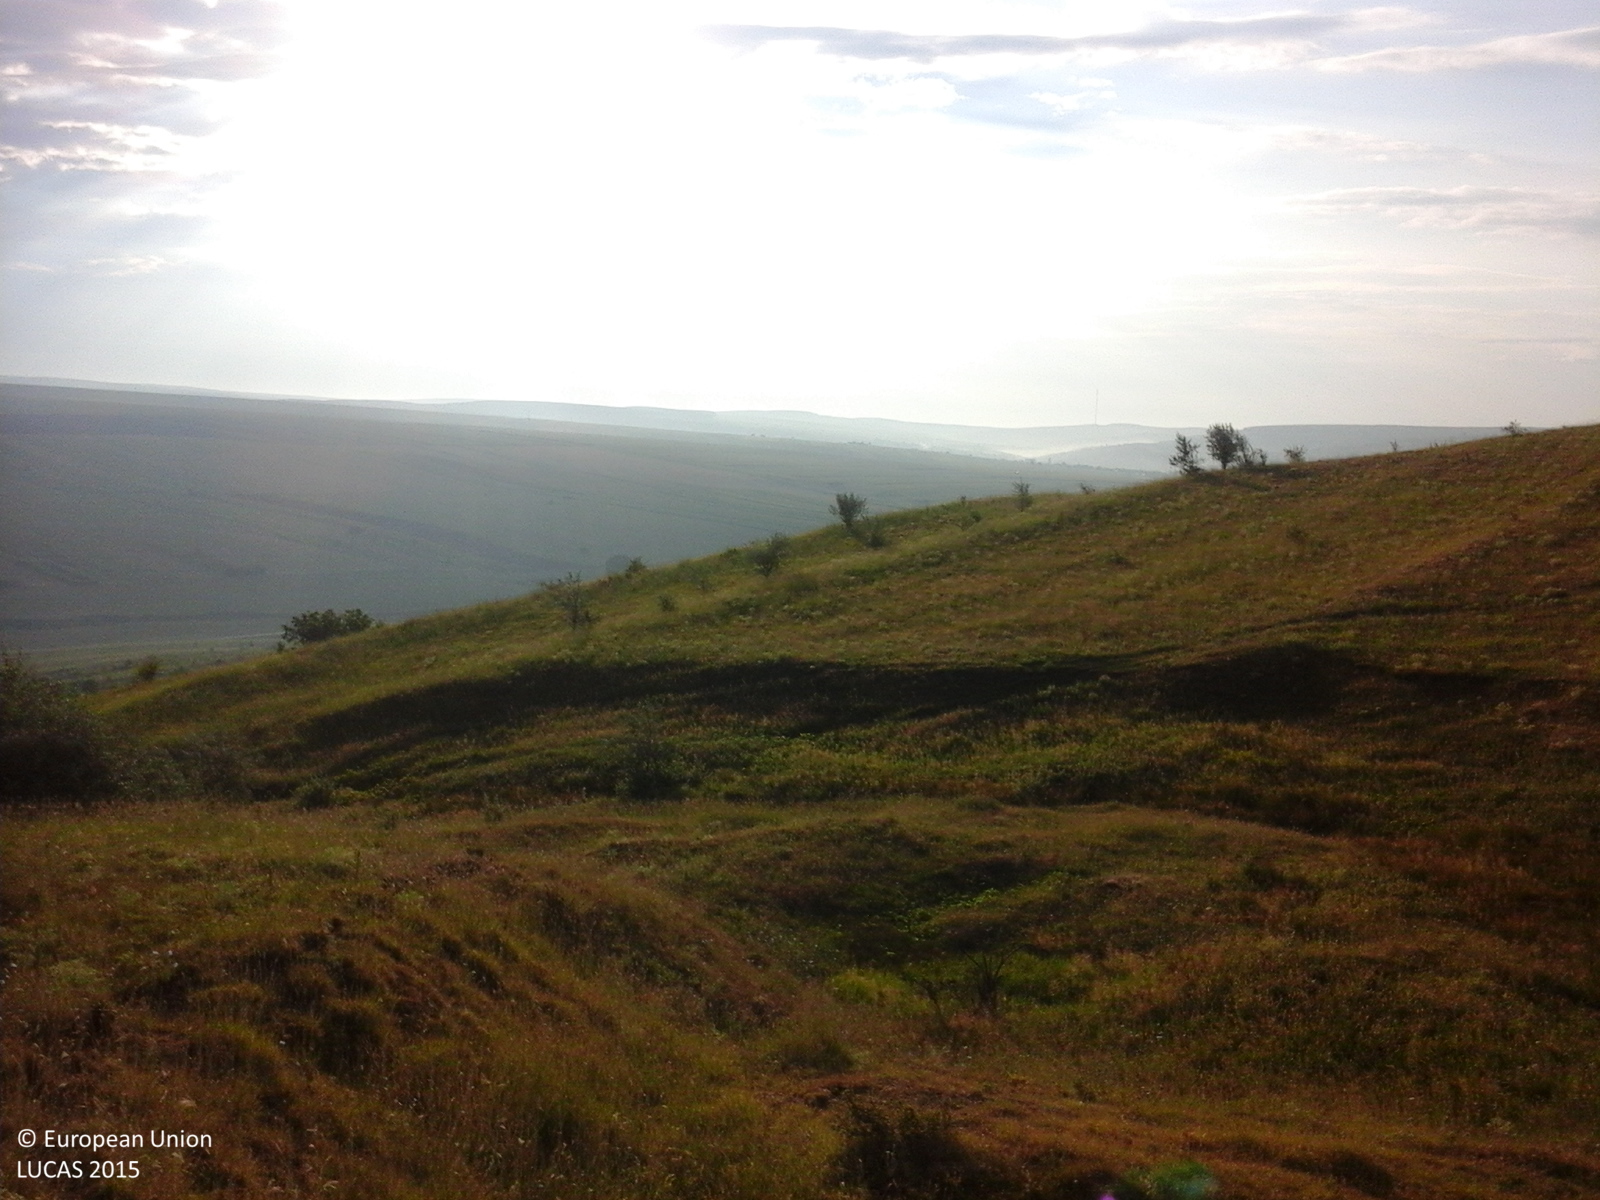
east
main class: Grassland
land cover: Grassland without tree/shrub cover
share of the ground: > 75 %
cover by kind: herbaceous plants 100 %
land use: Agriculture (excluding fallow land and kitchen gardens)
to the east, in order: Grassland without tree/shrub cover; Grassland with sparse tree/shrub cover; Grassland without tree/shrub cover; Grassland with sparse tree/shrub cover; Grassland without tree/shrub cover
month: July
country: RO
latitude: 46.2524
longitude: 27.7446
